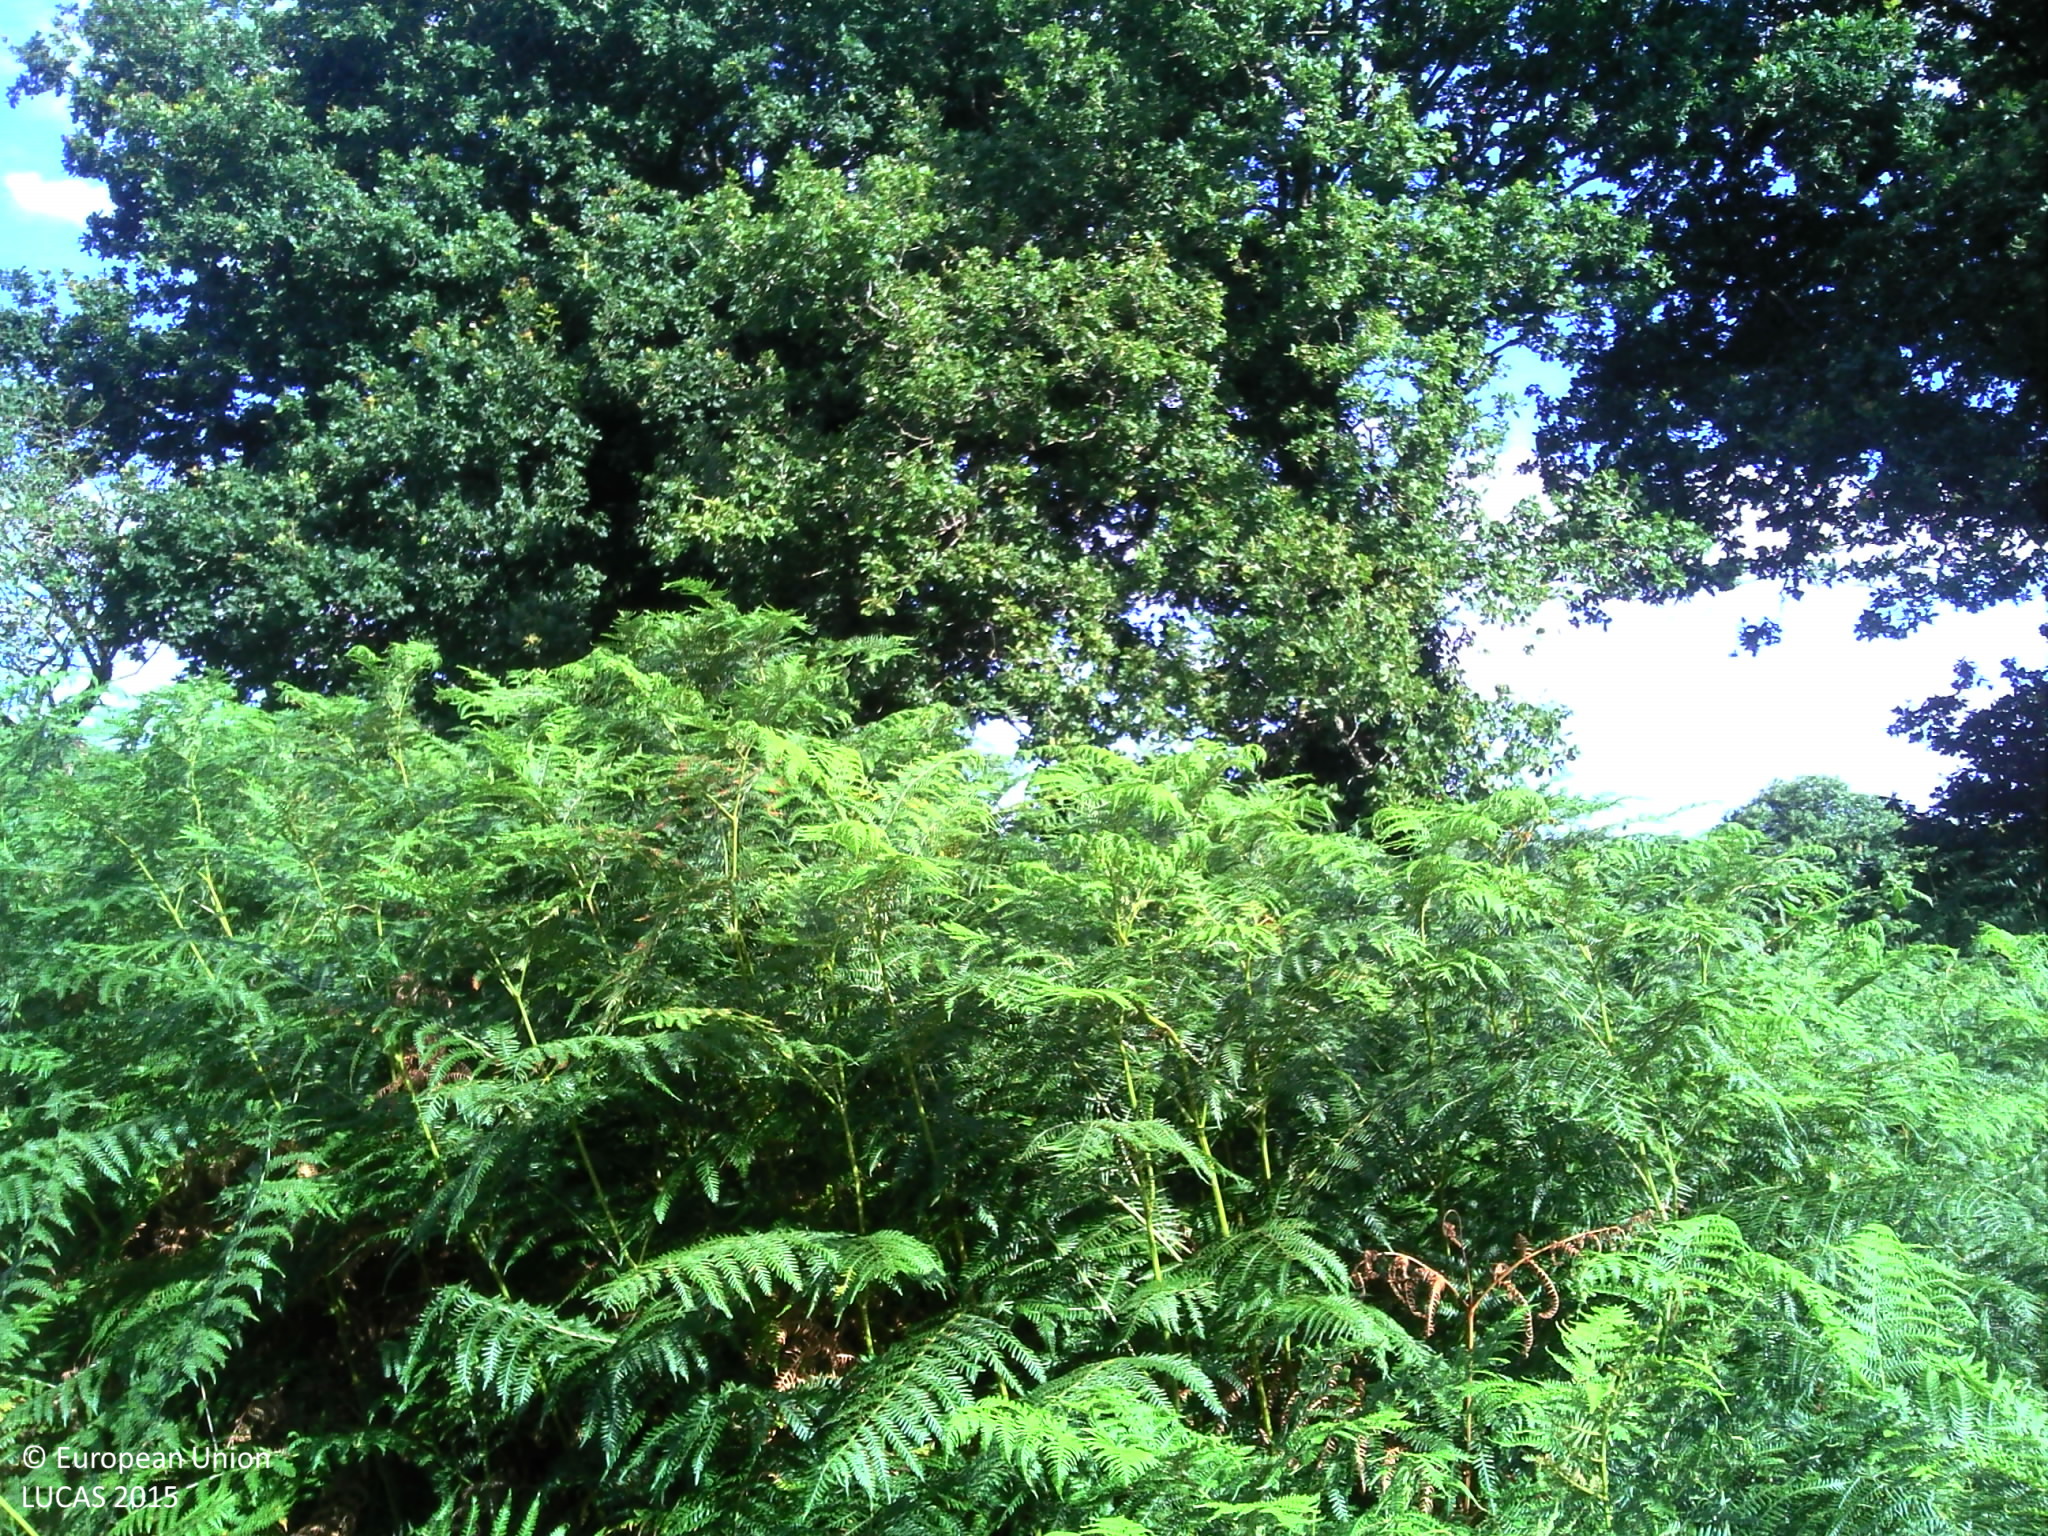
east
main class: Grassland
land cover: Spontaneously vegetated surfaces
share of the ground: > 75 %
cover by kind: herbaceous plants 95 %, shrubs 5 %
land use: Semi-natural and natural areas not in use
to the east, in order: Spontaneously vegetated surfaces; Broadleaved woodland; Grassland without tree/shrub cover; Lines of trees; Tracks; Fences; Lines of trees; Common wheat; Lines of trees; Fences; Spontaneously vegetated surfaces; Grassland without tree/shrub cover
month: August
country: FR
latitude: 48.4270
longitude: -3.3607
